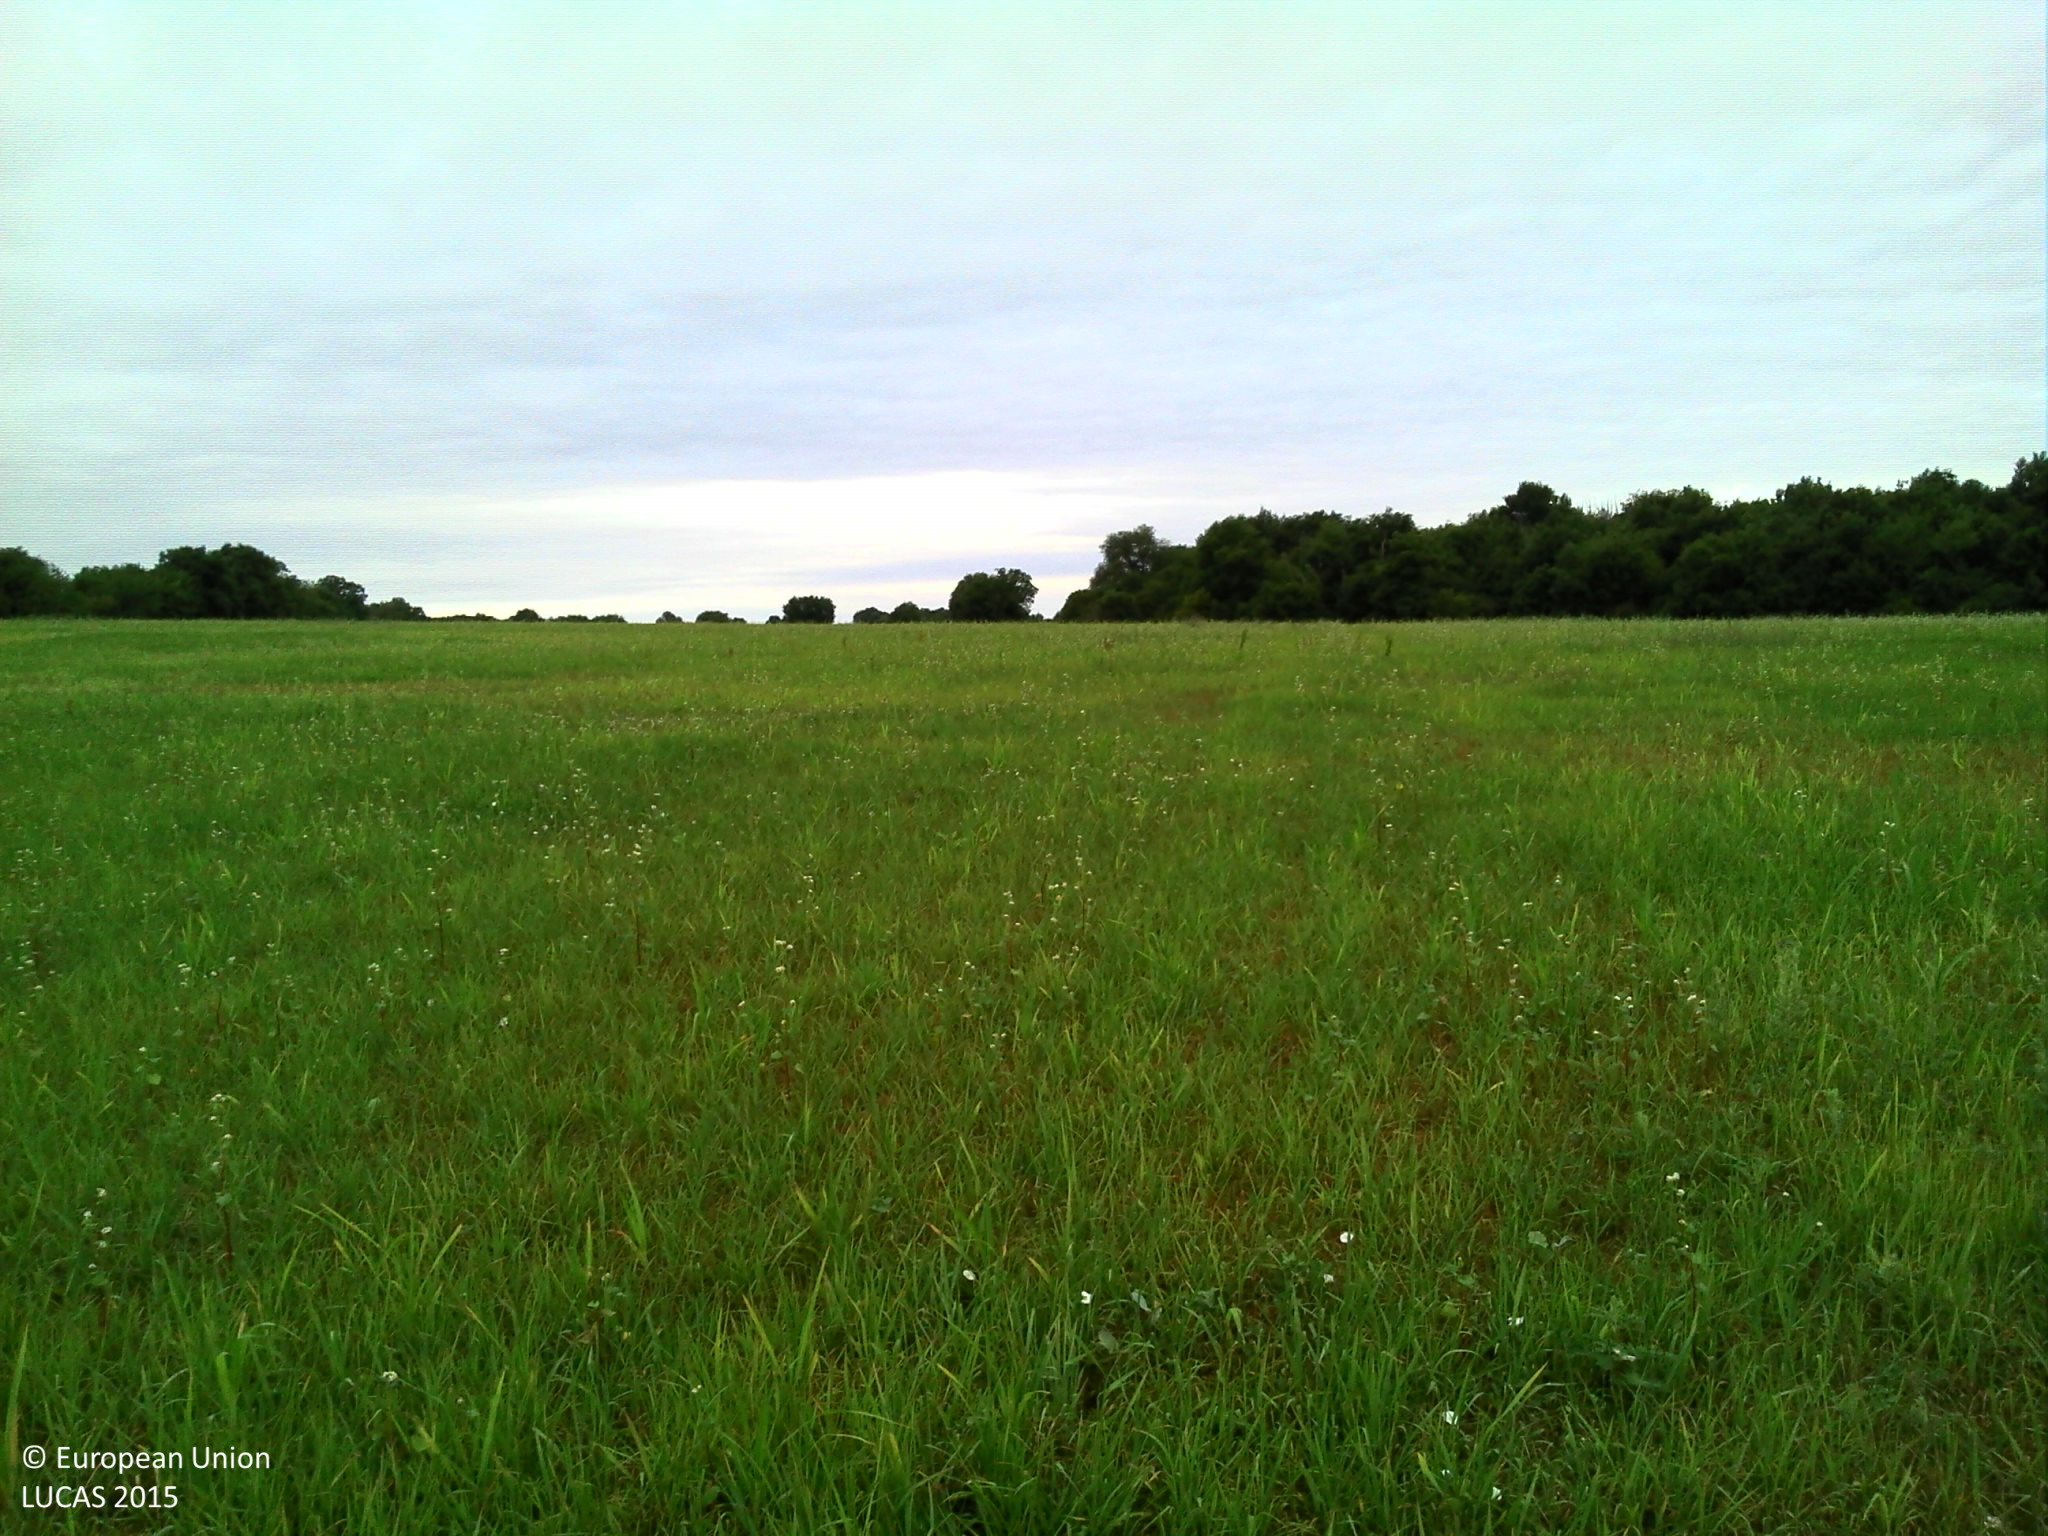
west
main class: Grassland
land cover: Grassland without tree/shrub cover
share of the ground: > 75 %
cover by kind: herbaceous plants 100 %
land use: Agriculture (excluding fallow land and kitchen gardens)
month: July
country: FR
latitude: 46.3569
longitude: 0.6400
